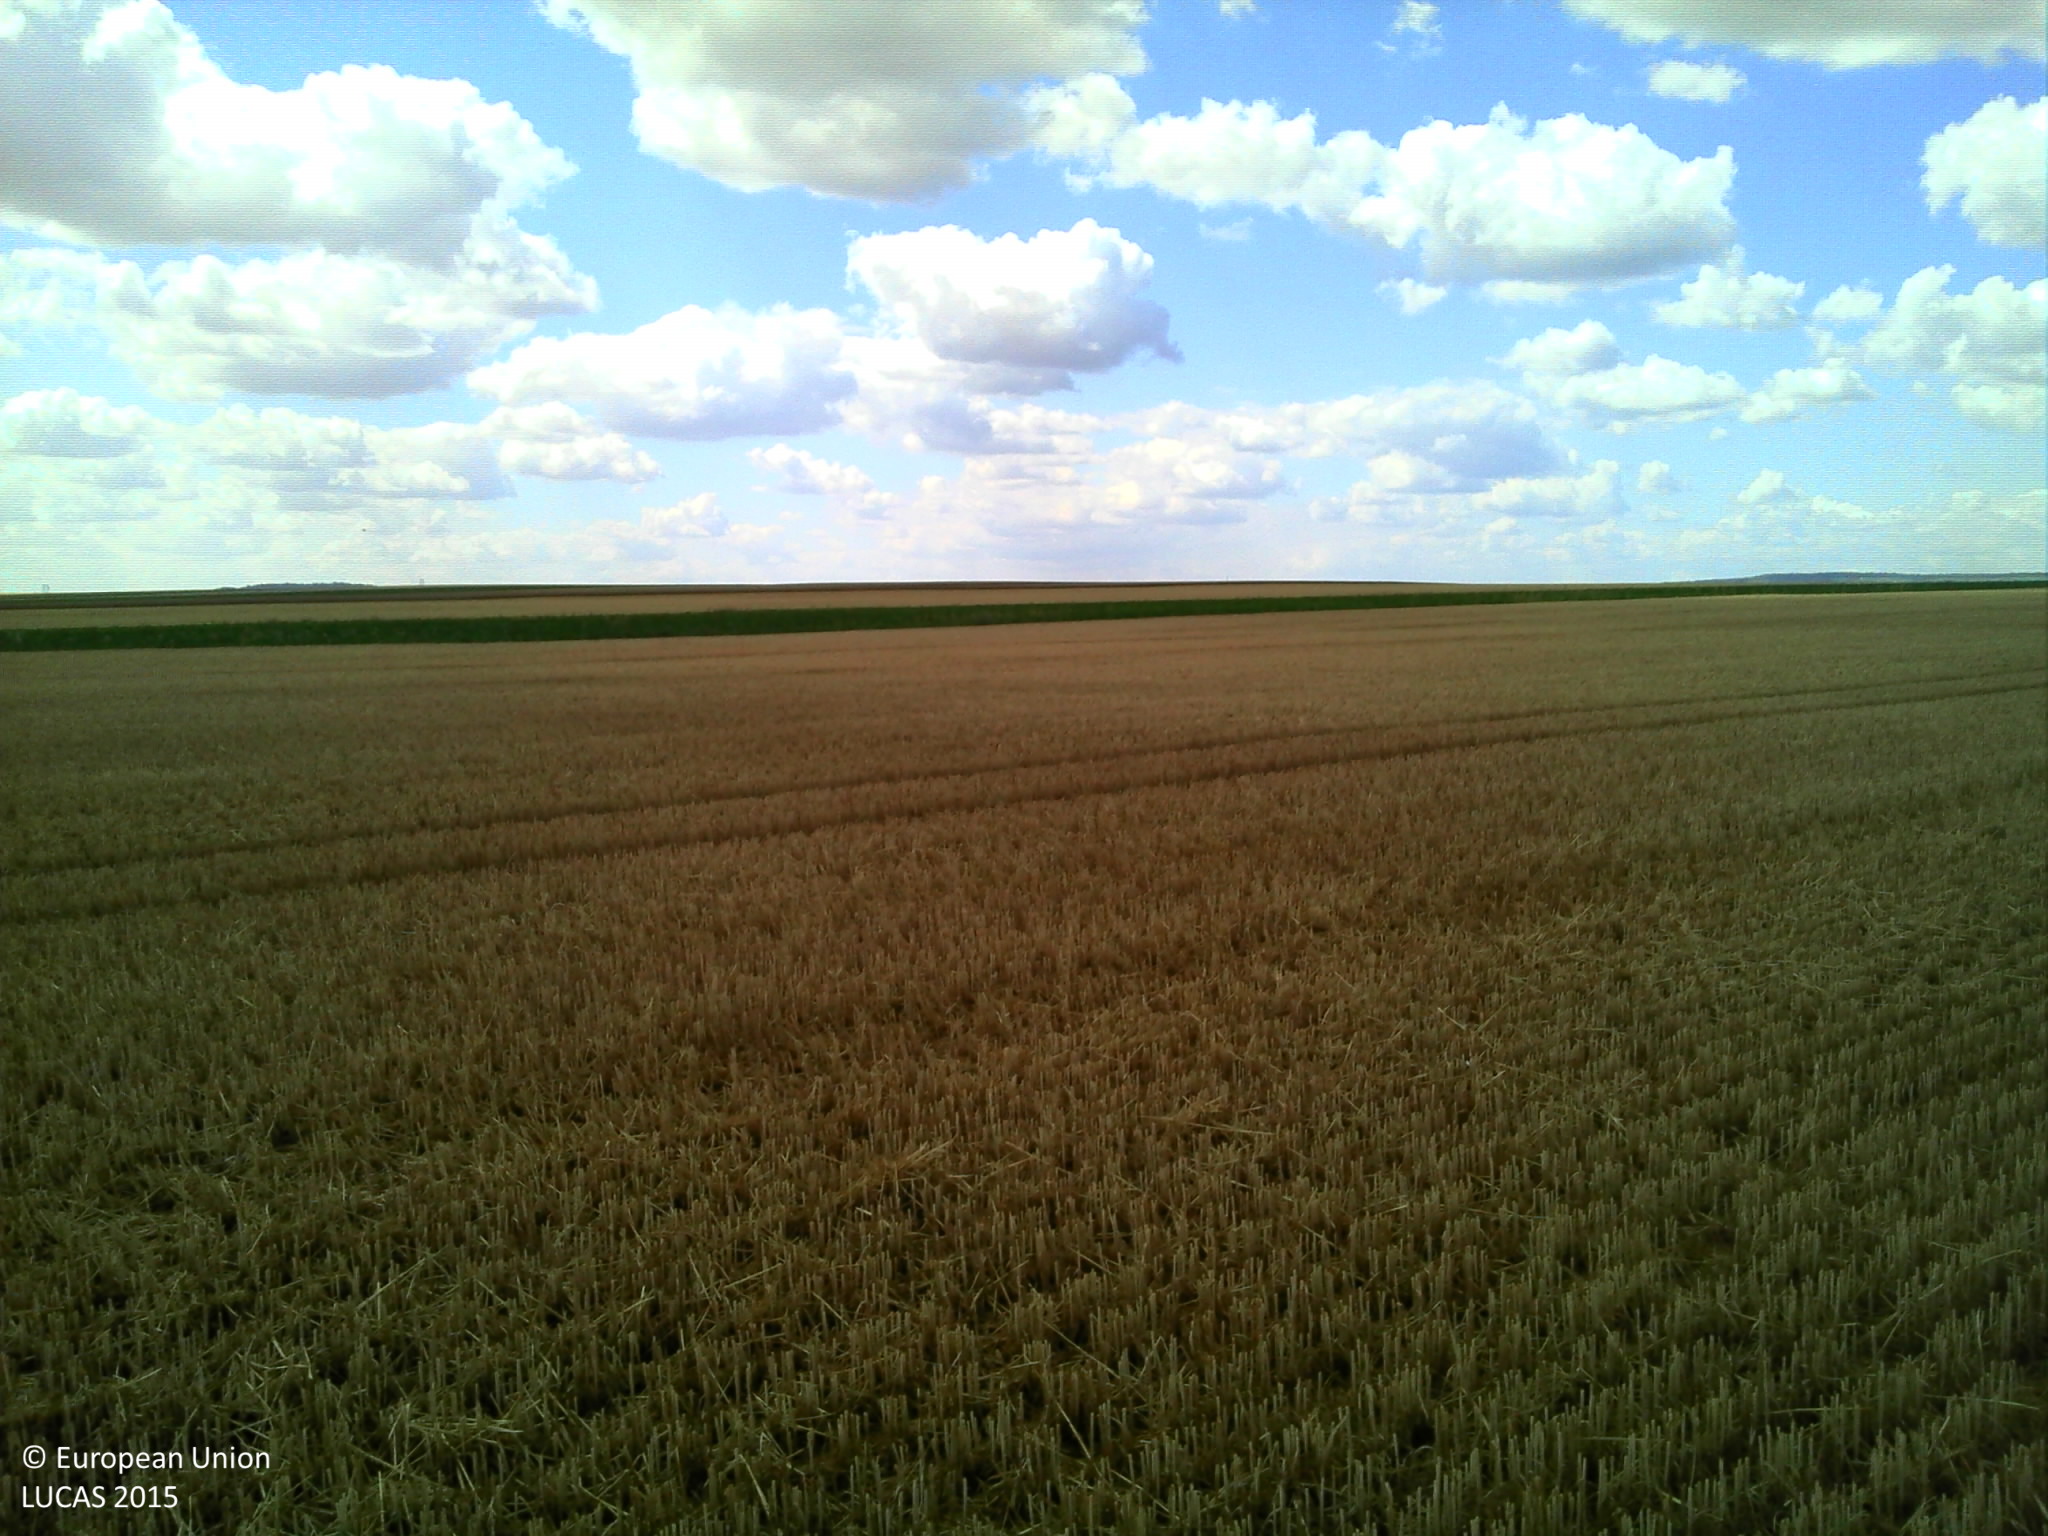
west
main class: Cropland
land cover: Common wheat
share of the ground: > 75 %
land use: Agriculture (excluding fallow land and kitchen gardens)
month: July
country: FR
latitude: 48.8783
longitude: 4.1187
